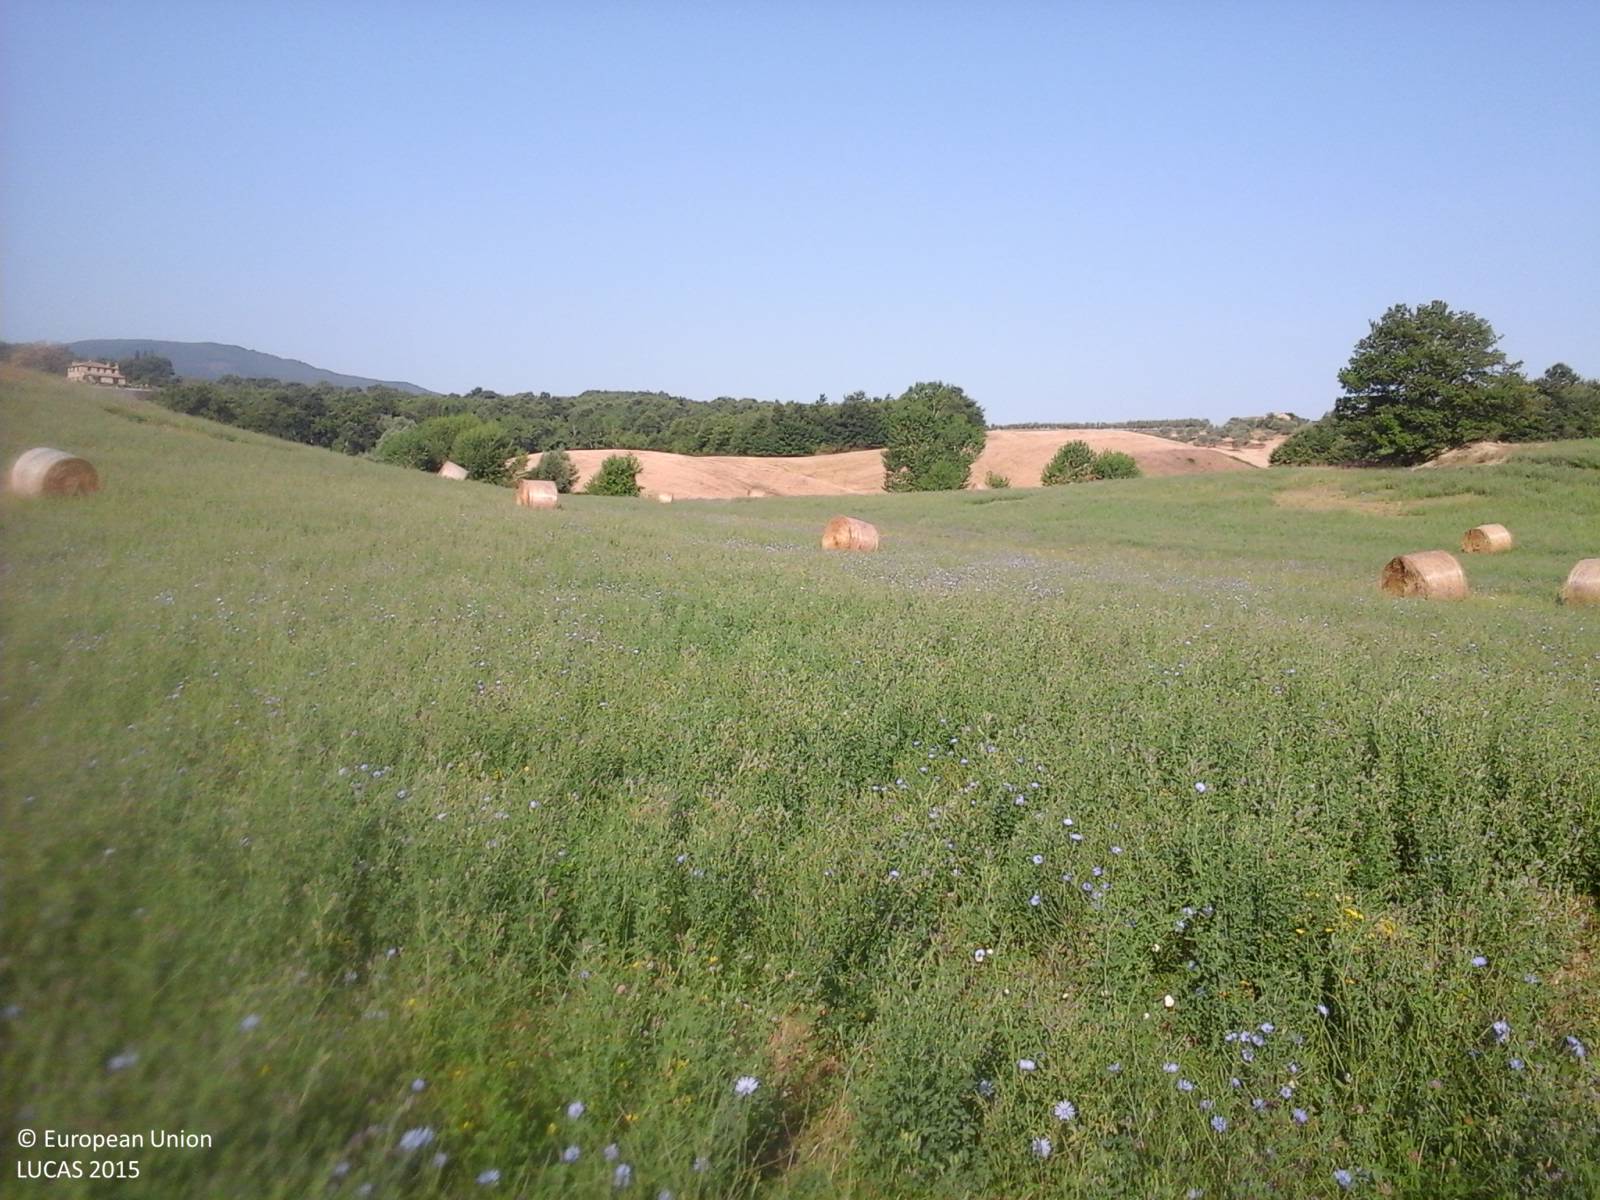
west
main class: Cropland
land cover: Lucerne
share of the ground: > 75 %
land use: Agriculture (excluding fallow land and kitchen gardens)
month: July
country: IT
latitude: 43.0341
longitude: 11.8722
